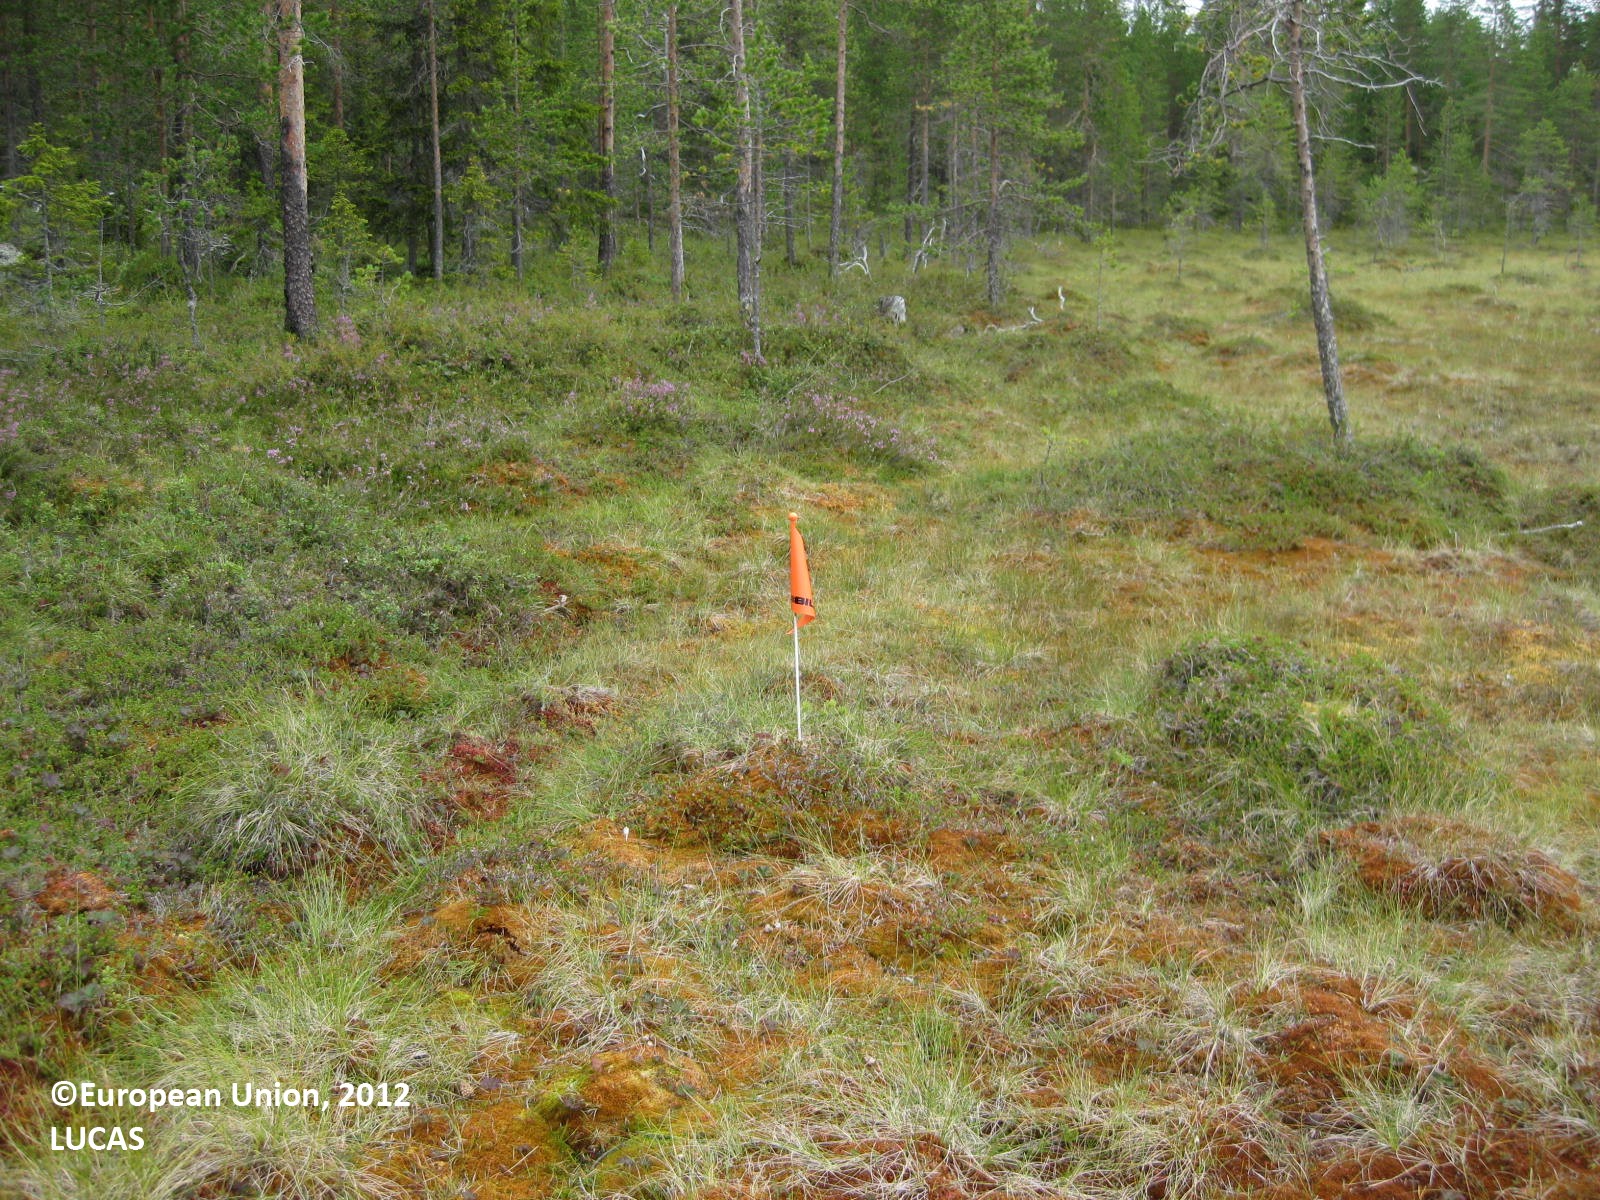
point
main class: Woodland
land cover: Pine dominated coniferous woodland
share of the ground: 25 - 50 %
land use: Semi-natural and natural areas not in use
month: August
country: FI
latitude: 66.3020
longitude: 28.3612
